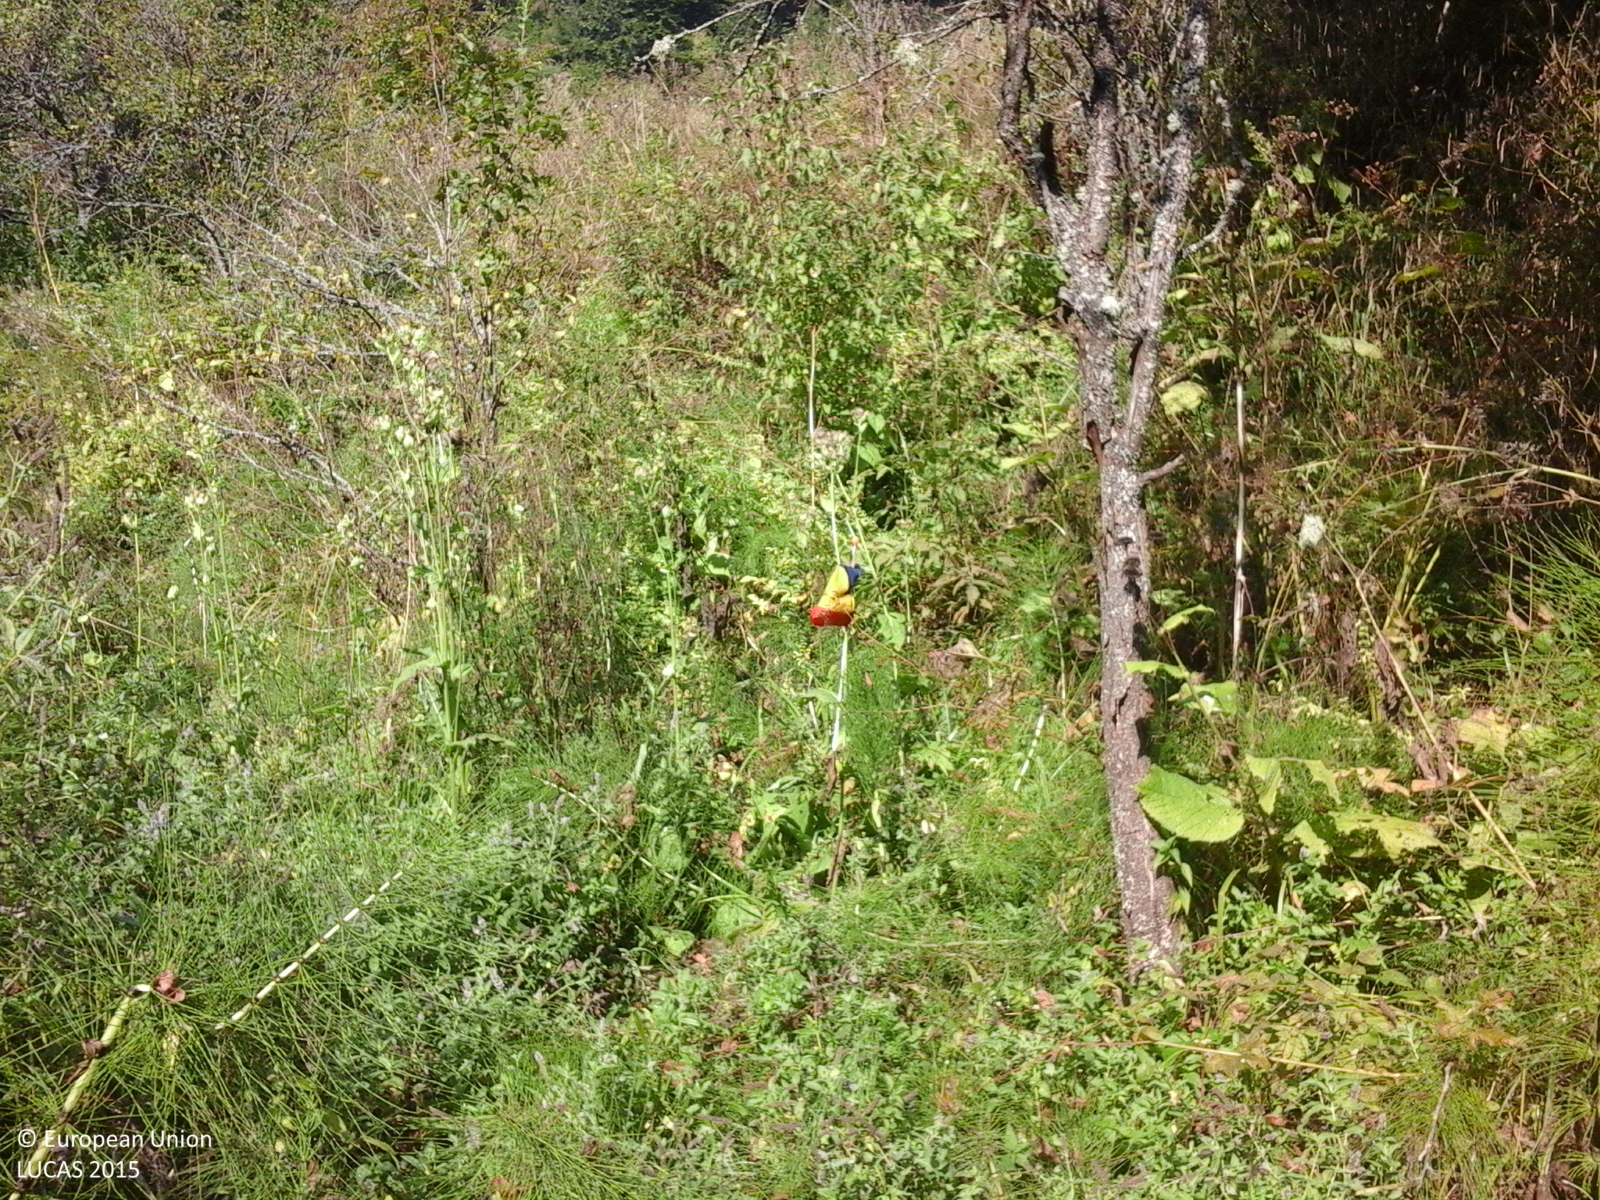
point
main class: Grassland
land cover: Grassland with sparse tree/shrub cover
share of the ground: > 75 %
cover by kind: herbaceous plants 85 %, shrubs 10 %, broadleaved forest trees 5 %
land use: Fallow land
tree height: < 5 m
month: September
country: RO
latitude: 47.3662
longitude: 24.3778
